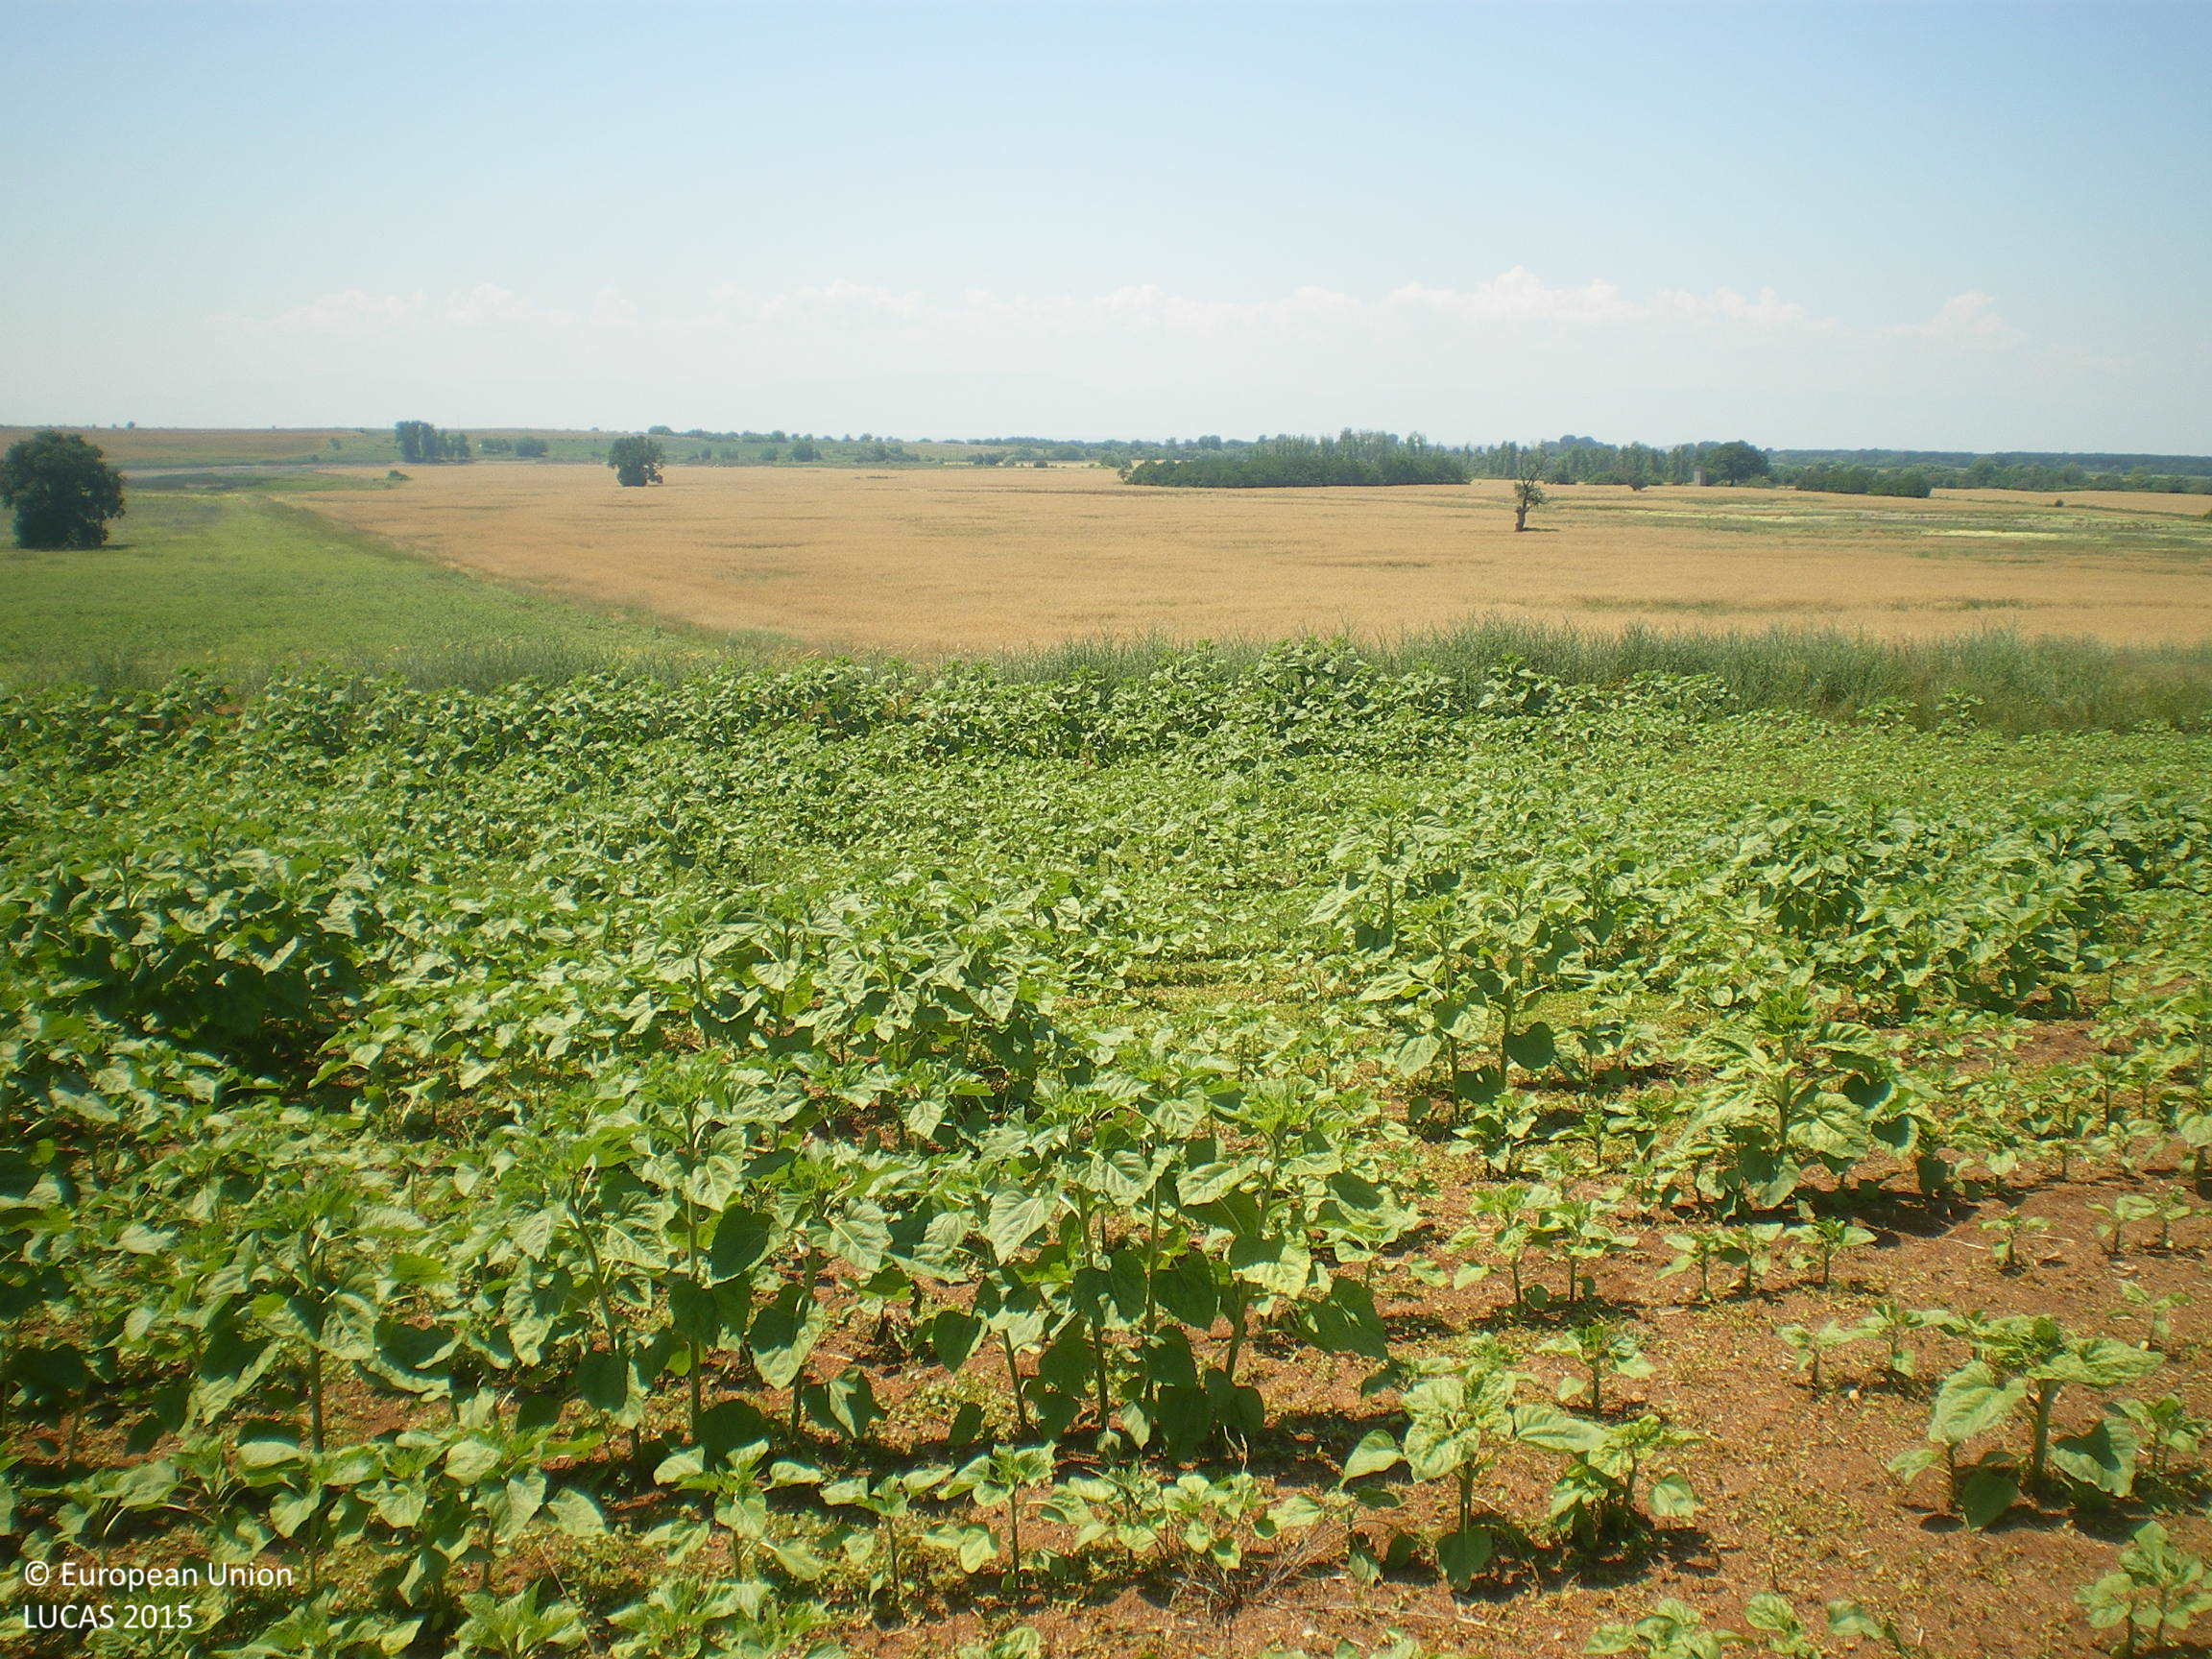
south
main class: Cropland
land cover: Sunflower
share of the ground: 50 - 75 %
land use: Agriculture (excluding fallow land and kitchen gardens)
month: June
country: BG
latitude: 42.2974
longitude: 25.1374
